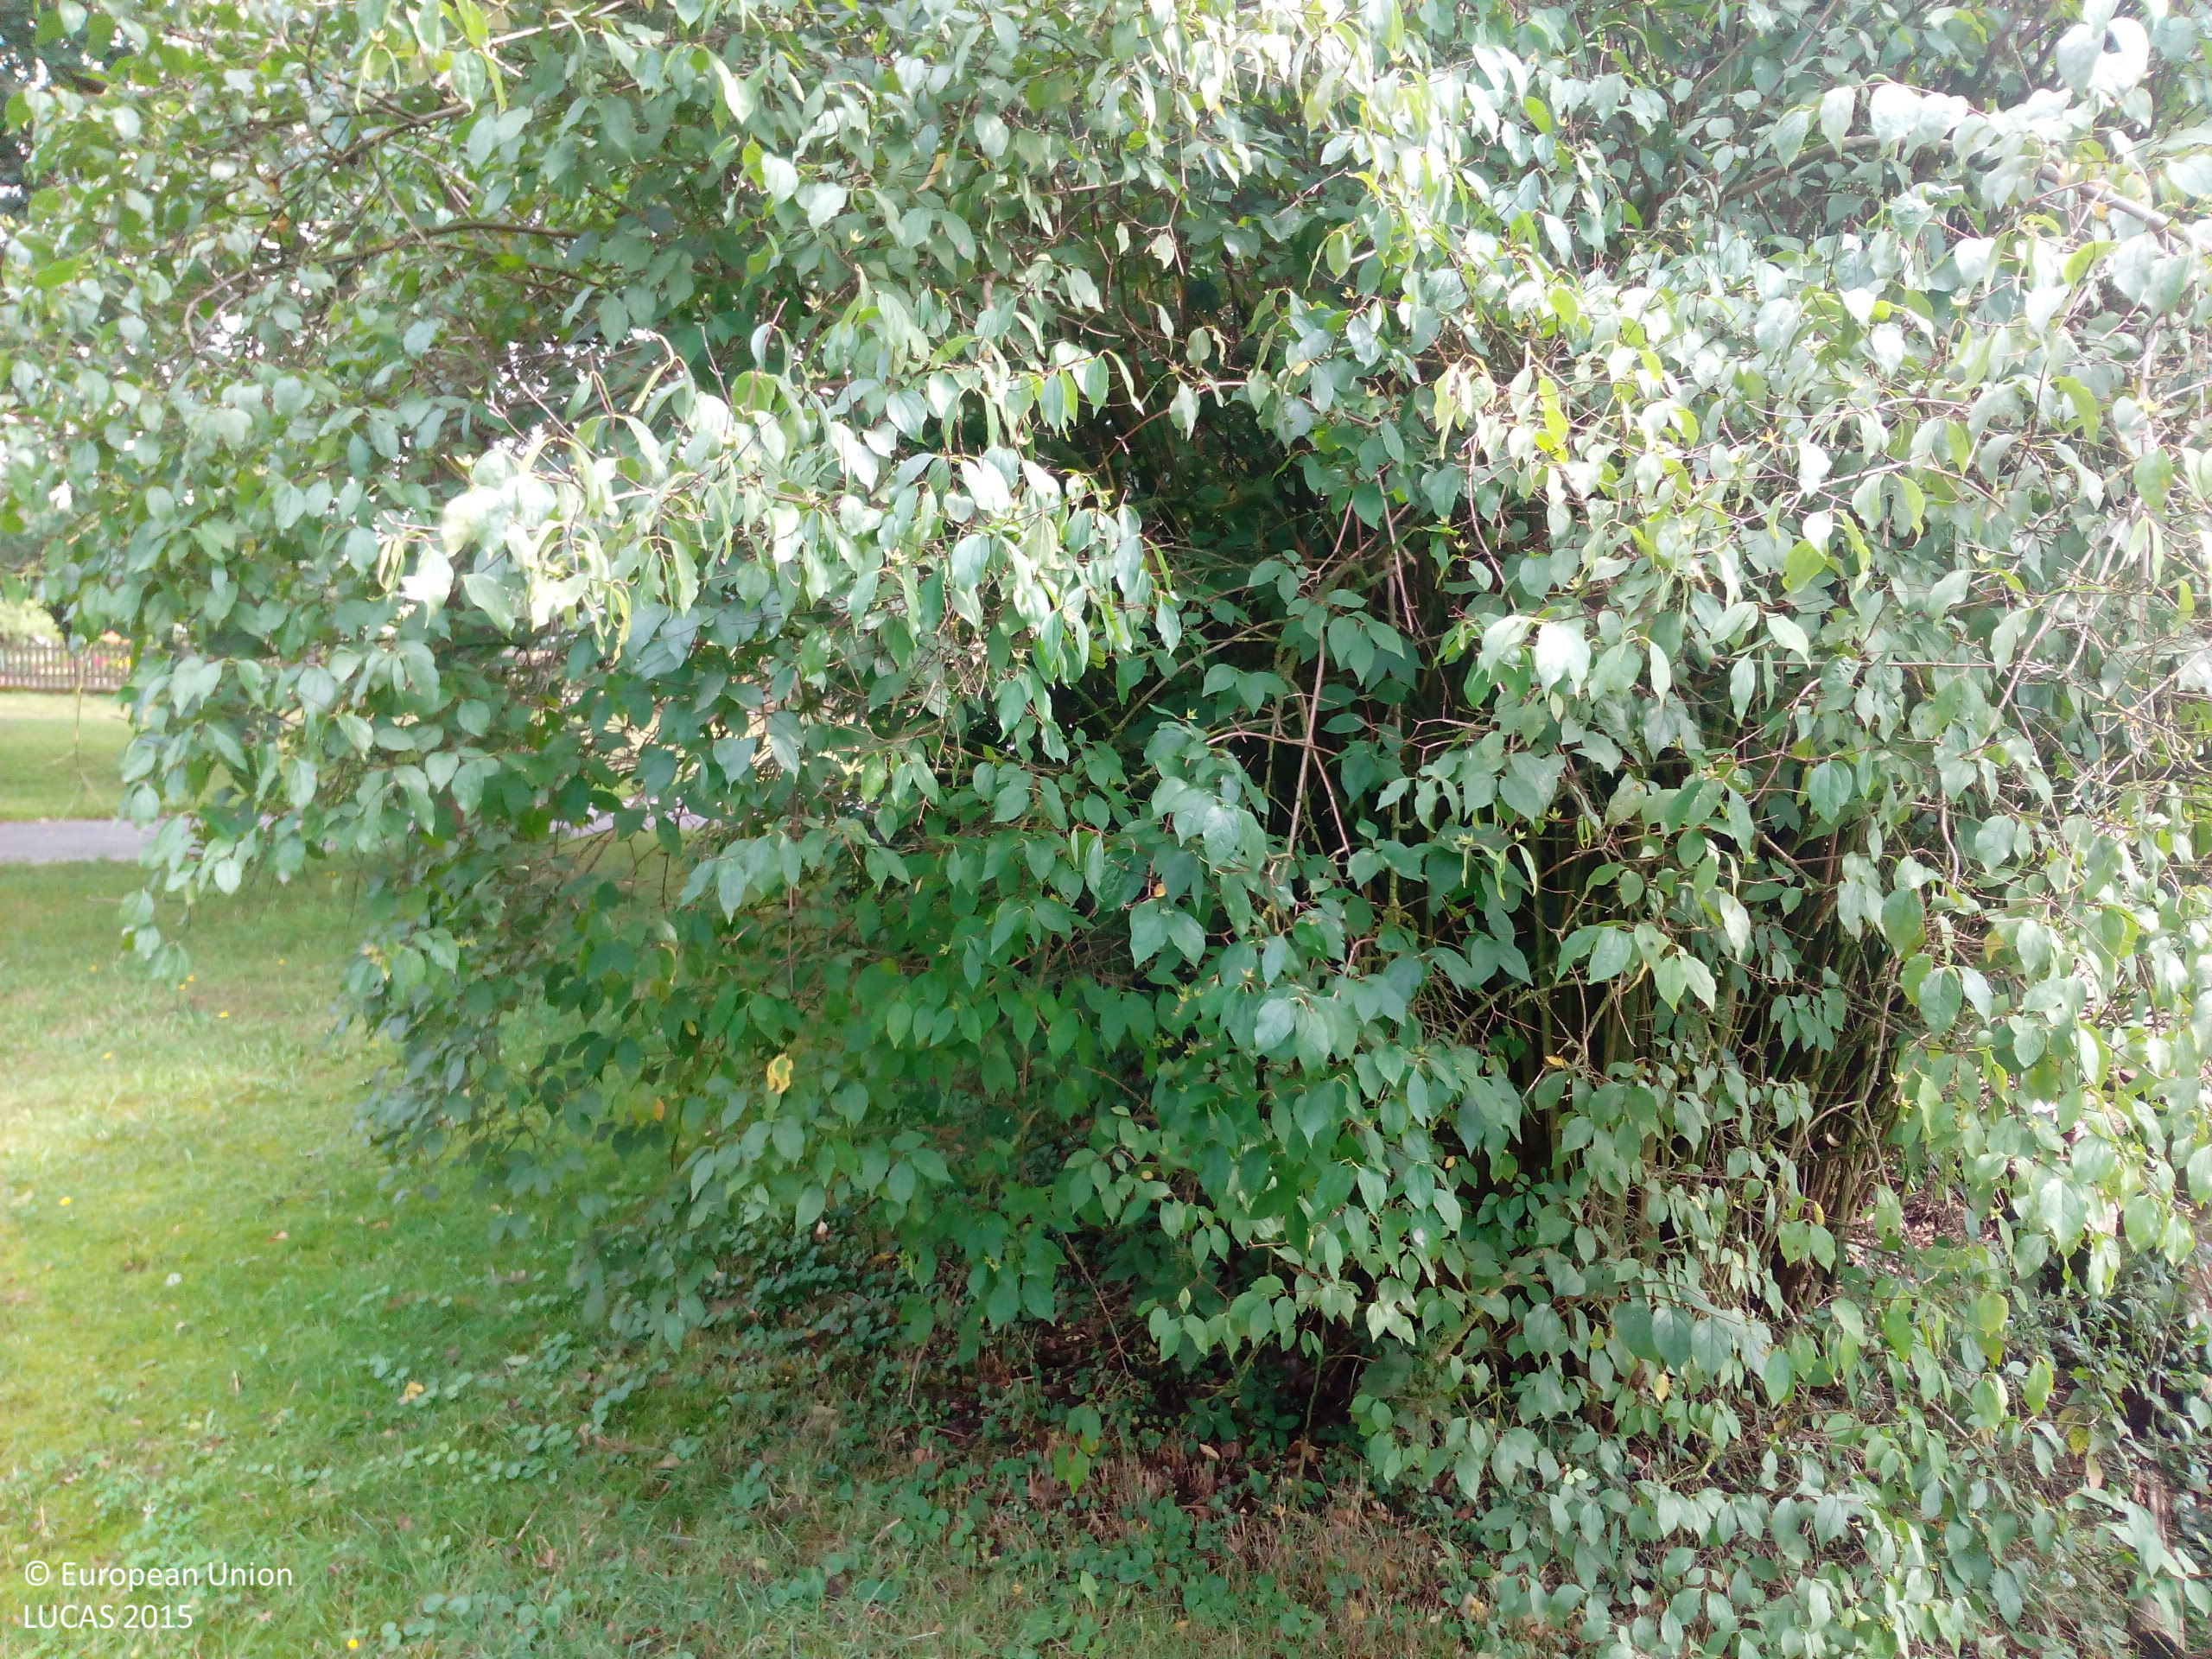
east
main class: Woodland
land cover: Broadleaved woodland
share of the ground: 25 - 50 %
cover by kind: herbaceous plants 55 %, broadleaved forest trees 30 %, shrubs 15 %
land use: Community services
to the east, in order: Broadleaved woodland; Artificial constructions in urban areas; Grassland without tree/shrub cover; Common wheat
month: August
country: DE
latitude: 52.9870
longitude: 10.6105
